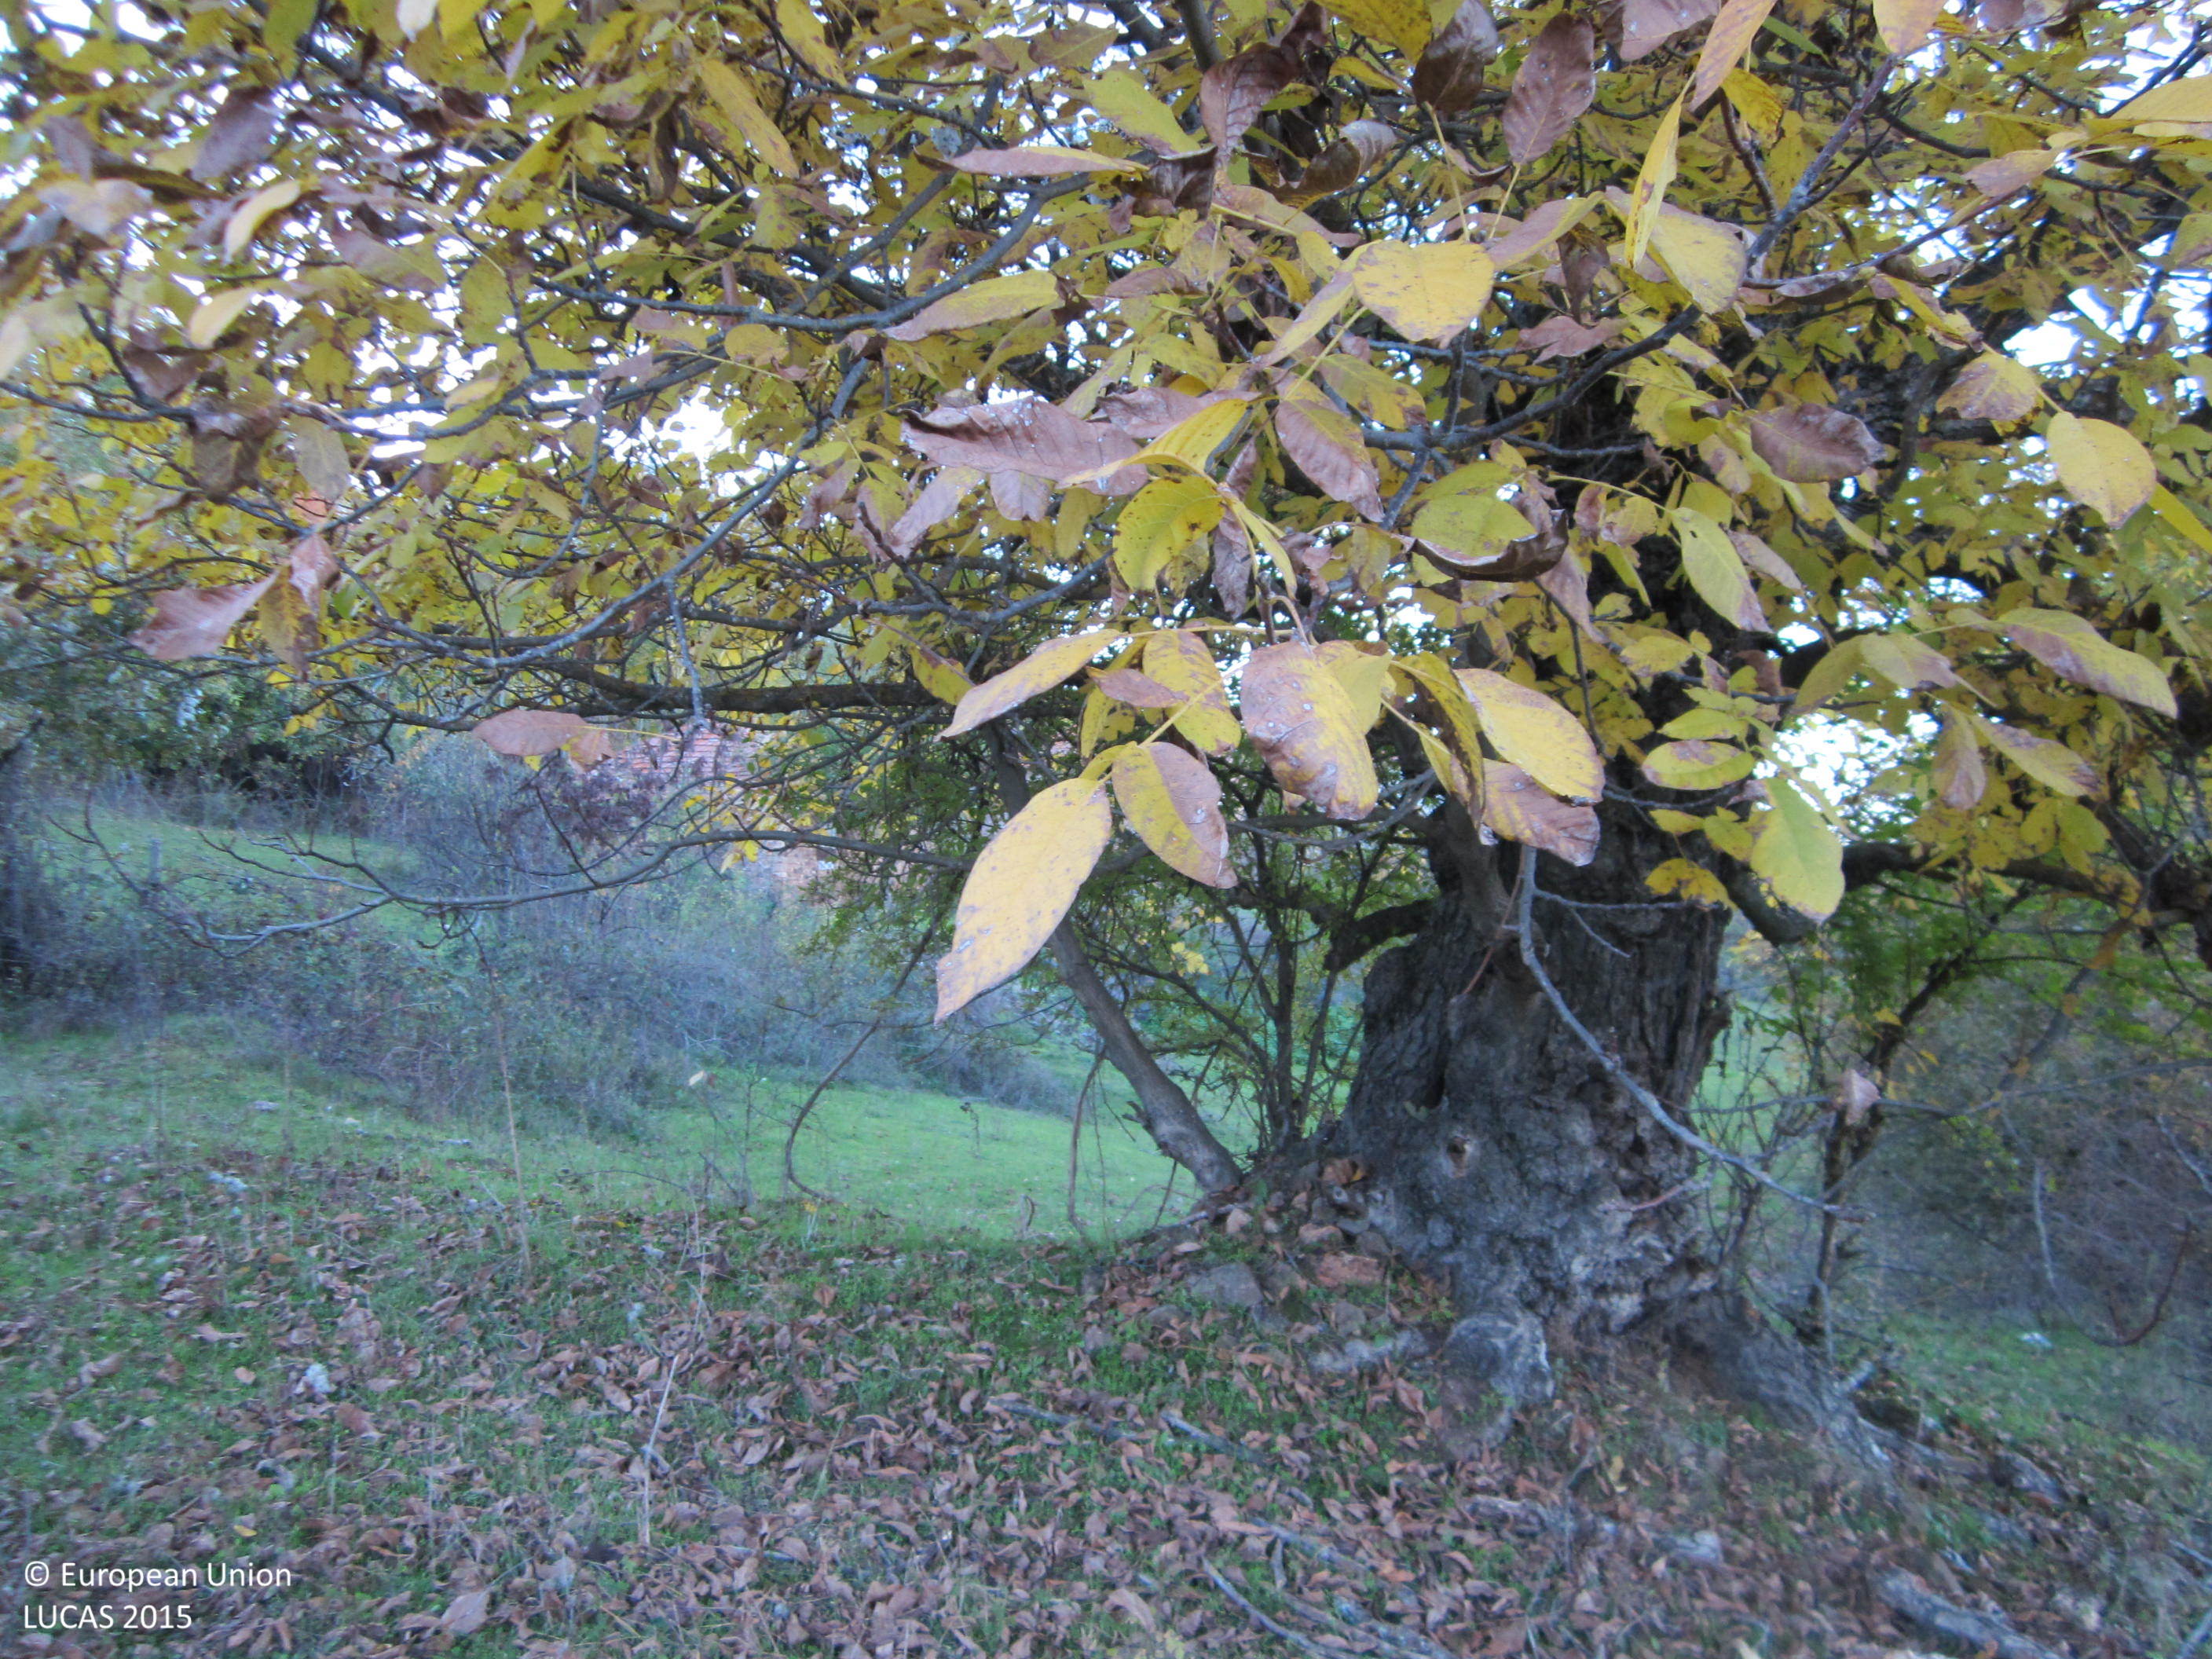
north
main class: Grassland
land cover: Grassland with sparse tree/shrub cover
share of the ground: > 75 %
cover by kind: herbaceous plants 90 %, broadleaved forest trees 5 %, shrubs 5 %
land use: Agriculture (excluding fallow land and kitchen gardens)
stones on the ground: < 10 %
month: November
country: BG
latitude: 41.4108
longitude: 25.6471
